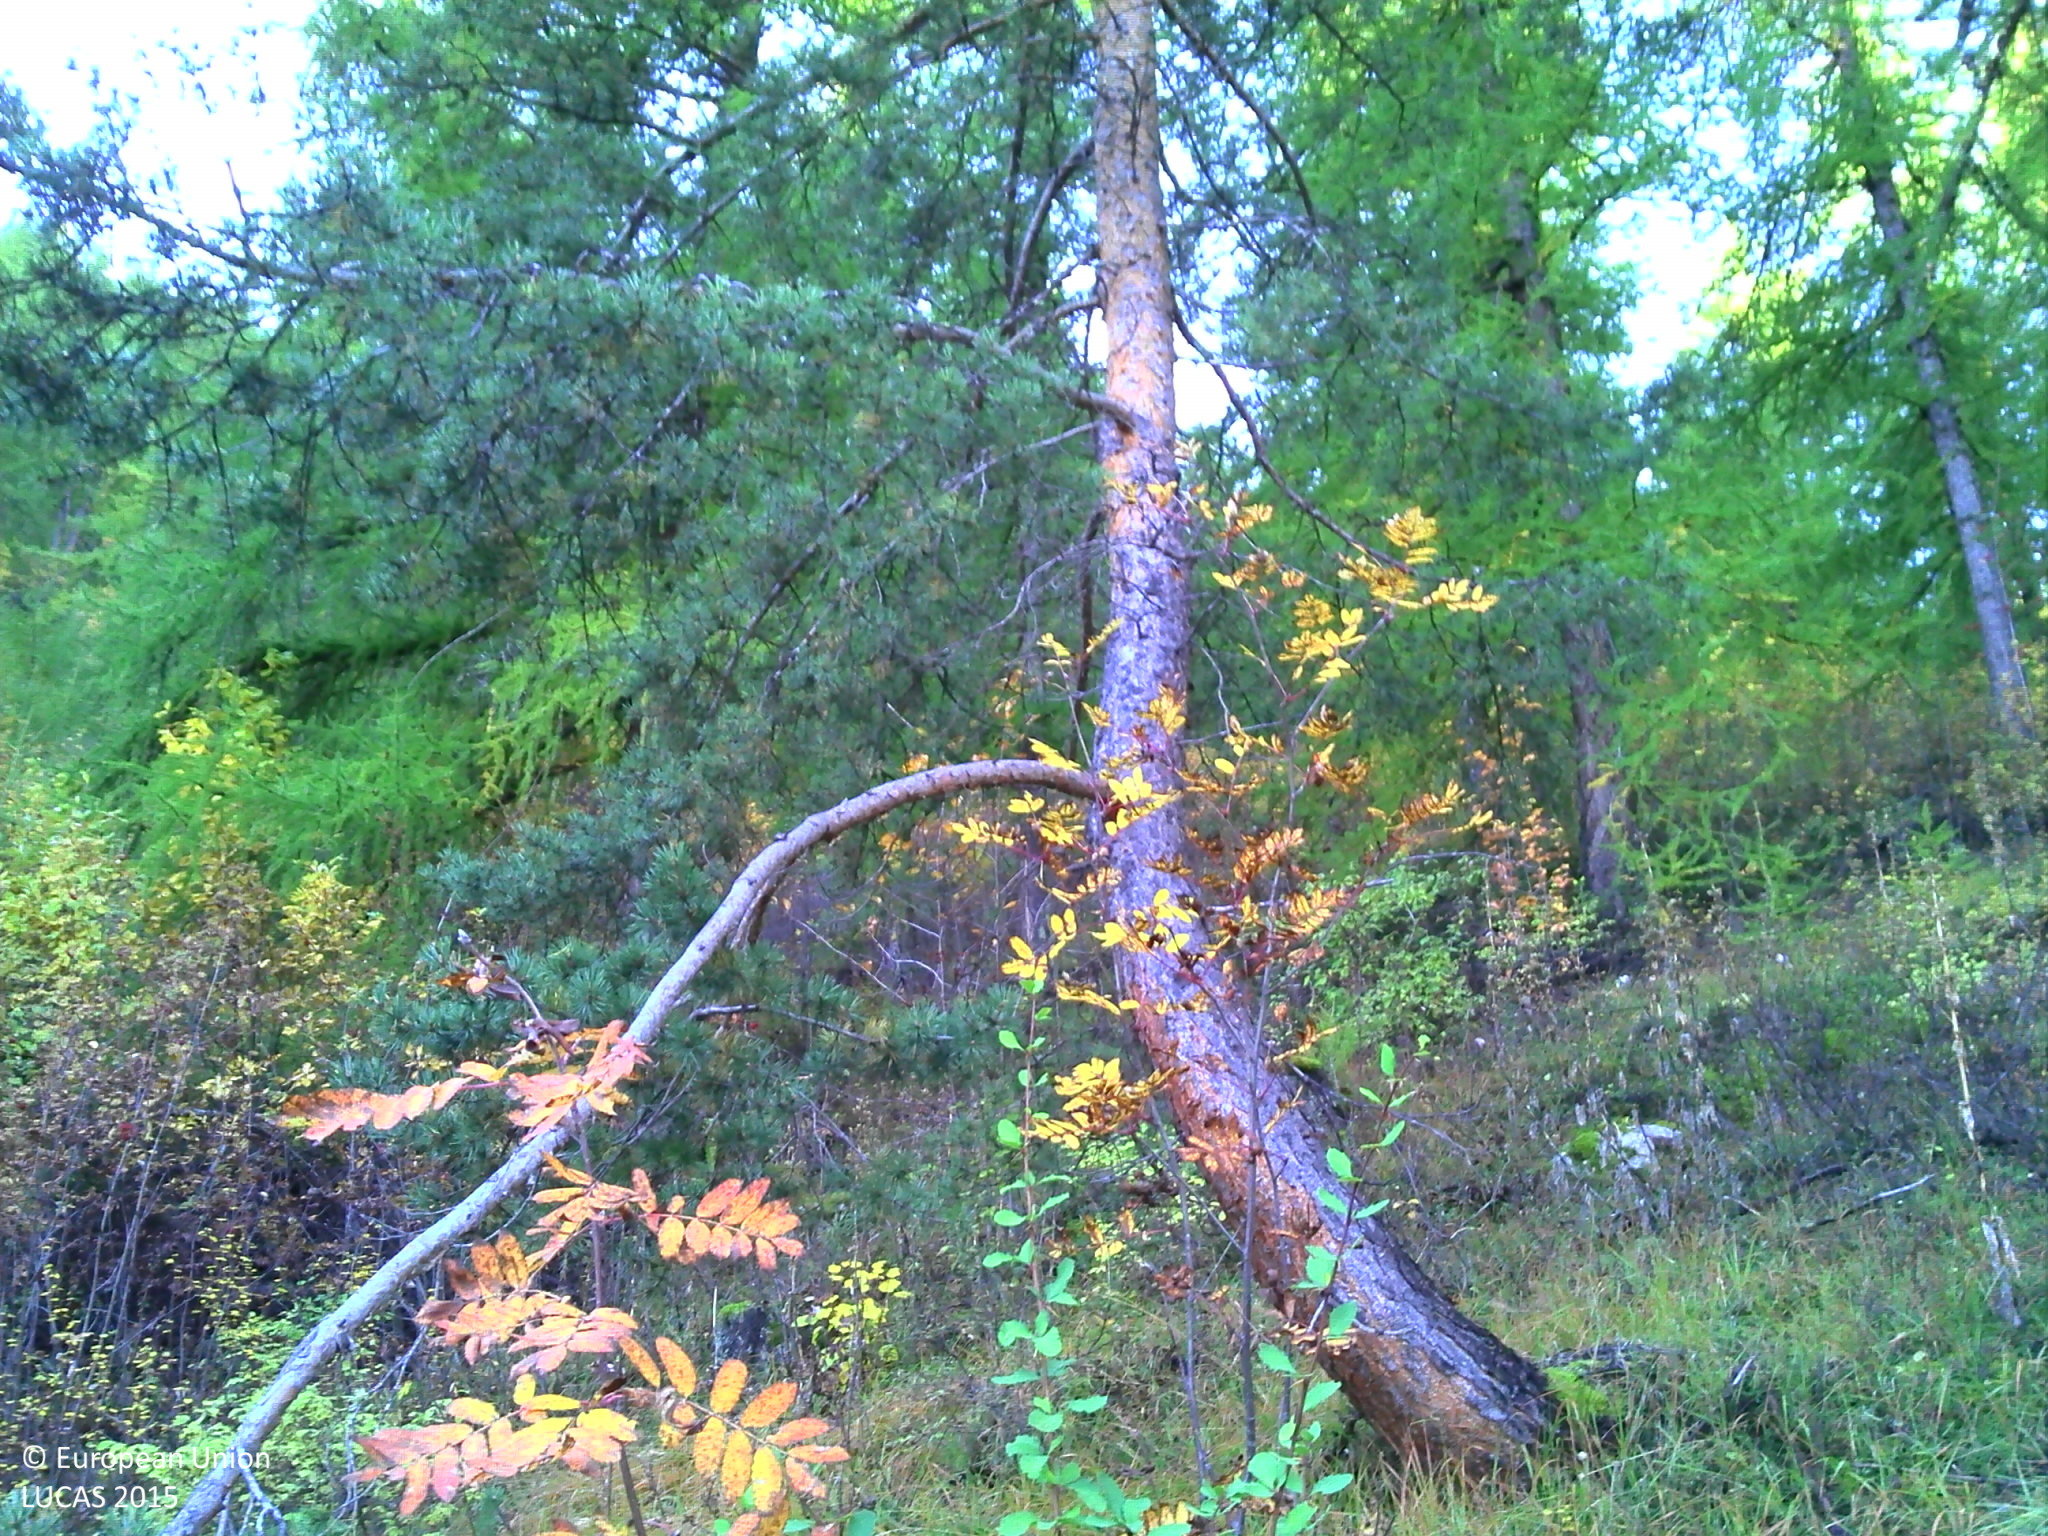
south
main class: Woodland
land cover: Pine dominated coniferous woodland
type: alpine coniferous forest
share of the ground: > 75 %
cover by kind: coniferous forest trees 60 %, herbaceous plants 15 %, broadleaved forest trees 10 %, unconsolidated bare surface 10 %, shrubs 5 %
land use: Forestry
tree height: > 5 m
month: October
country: FR
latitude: 44.7087
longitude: 6.5601
